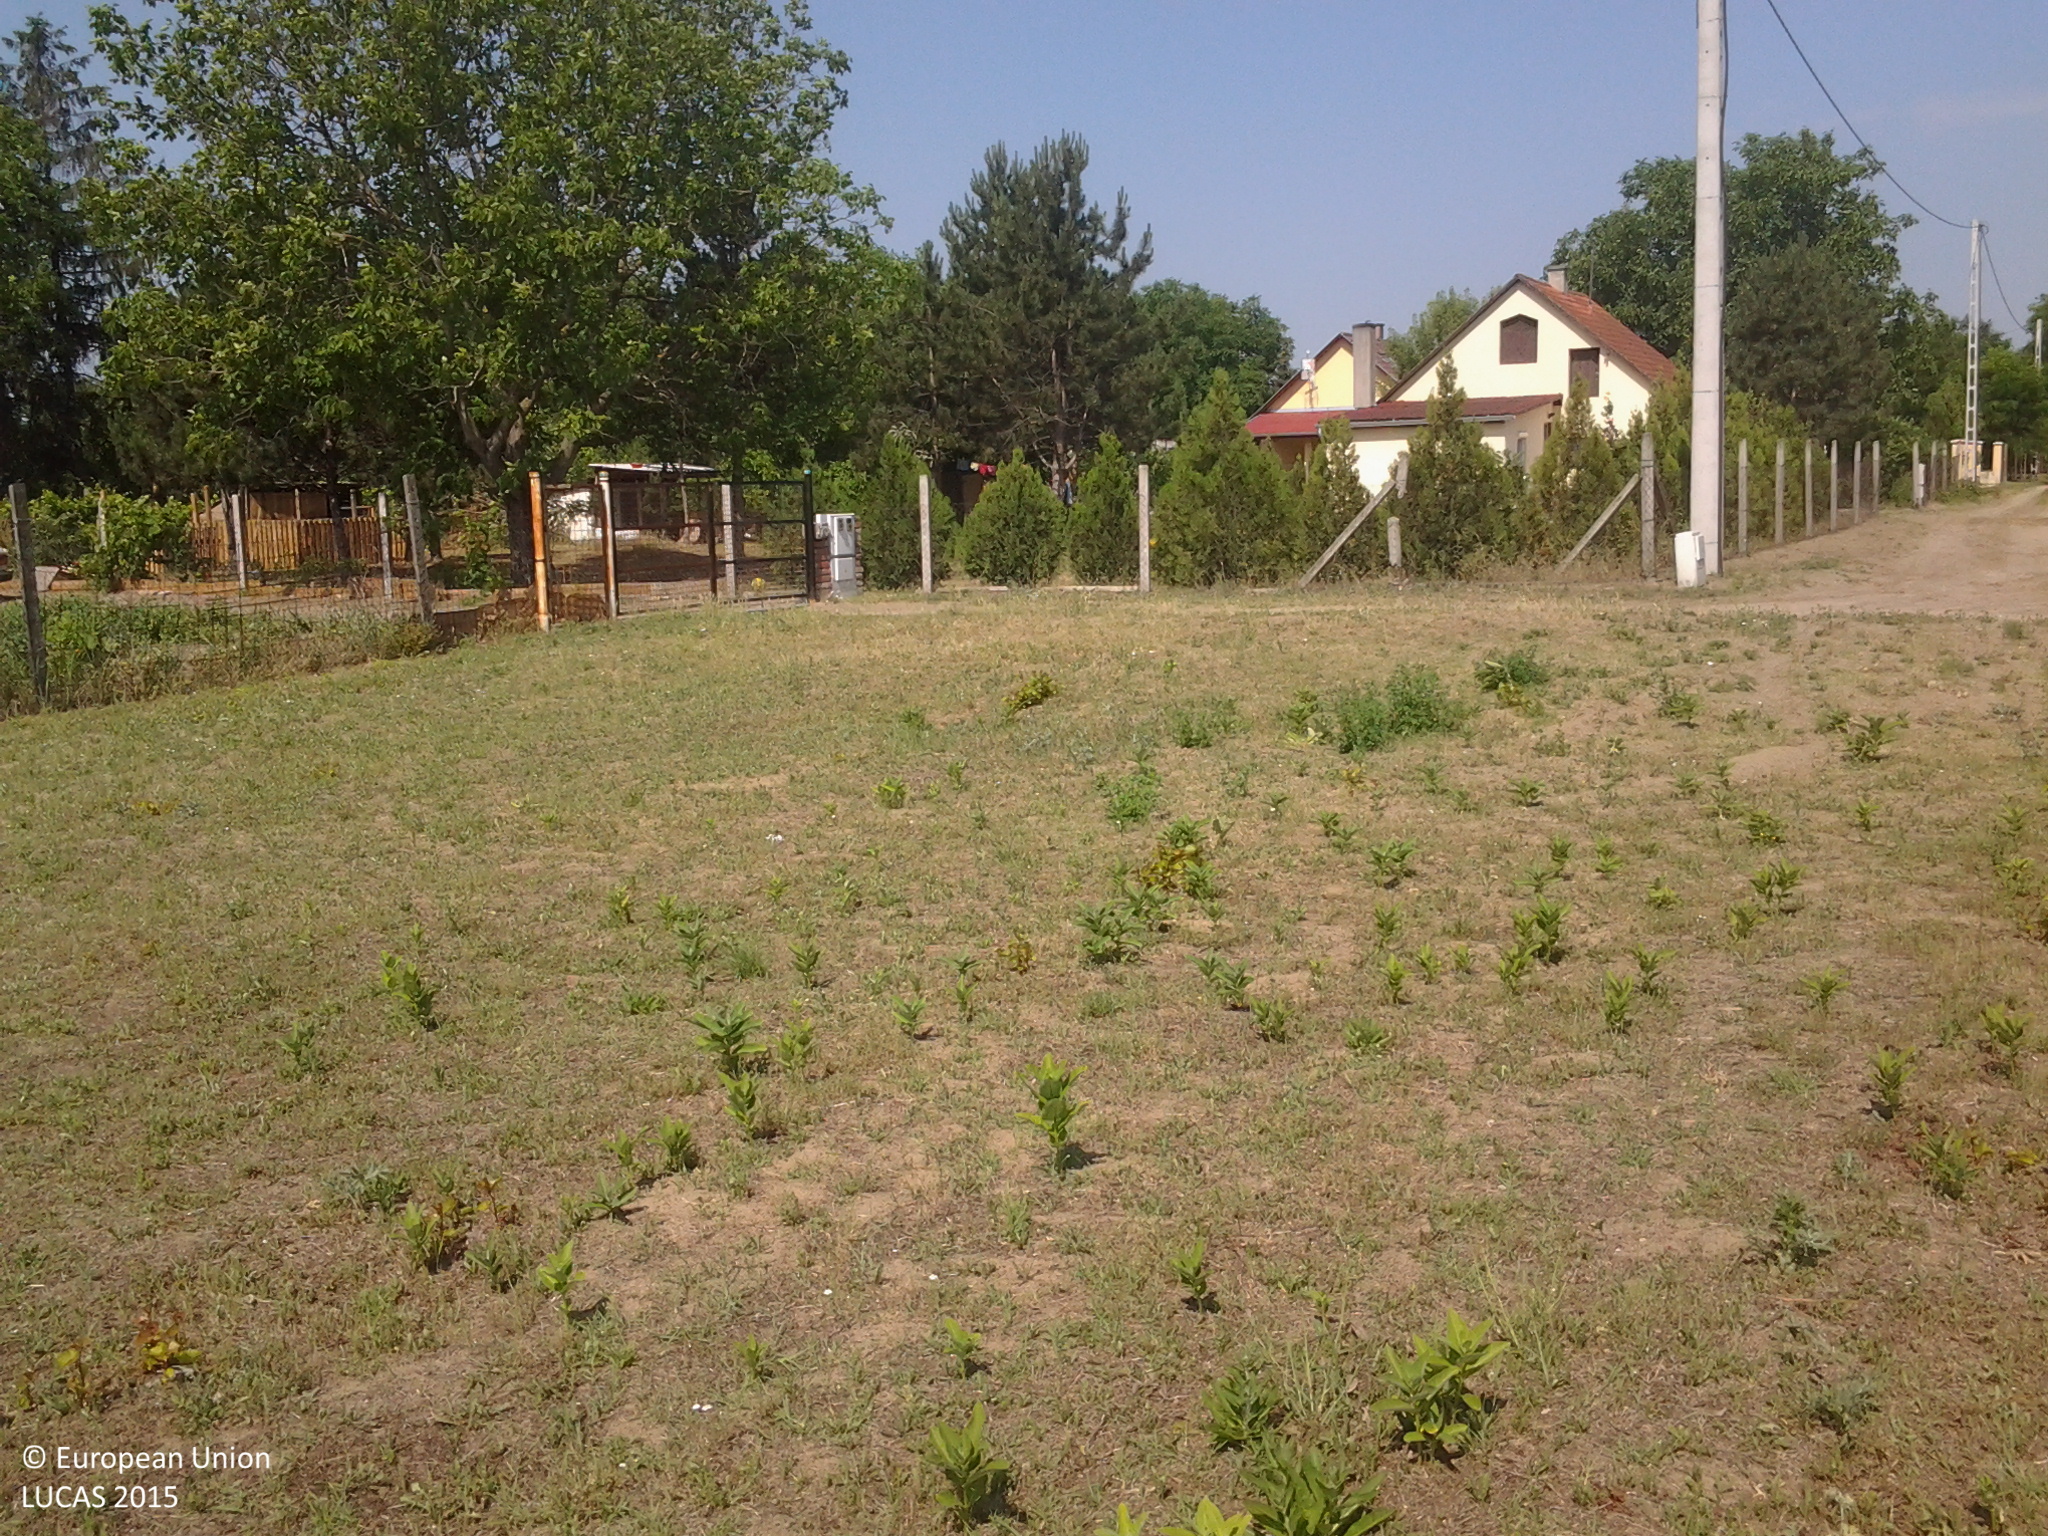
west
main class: Grassland
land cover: Spontaneously vegetated surfaces
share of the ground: > 75 %
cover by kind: herbaceous plants 95 %, unconsolidated bare surface 5 %
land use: Fallow land
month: June
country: HU
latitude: 46.9140
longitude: 19.6183
